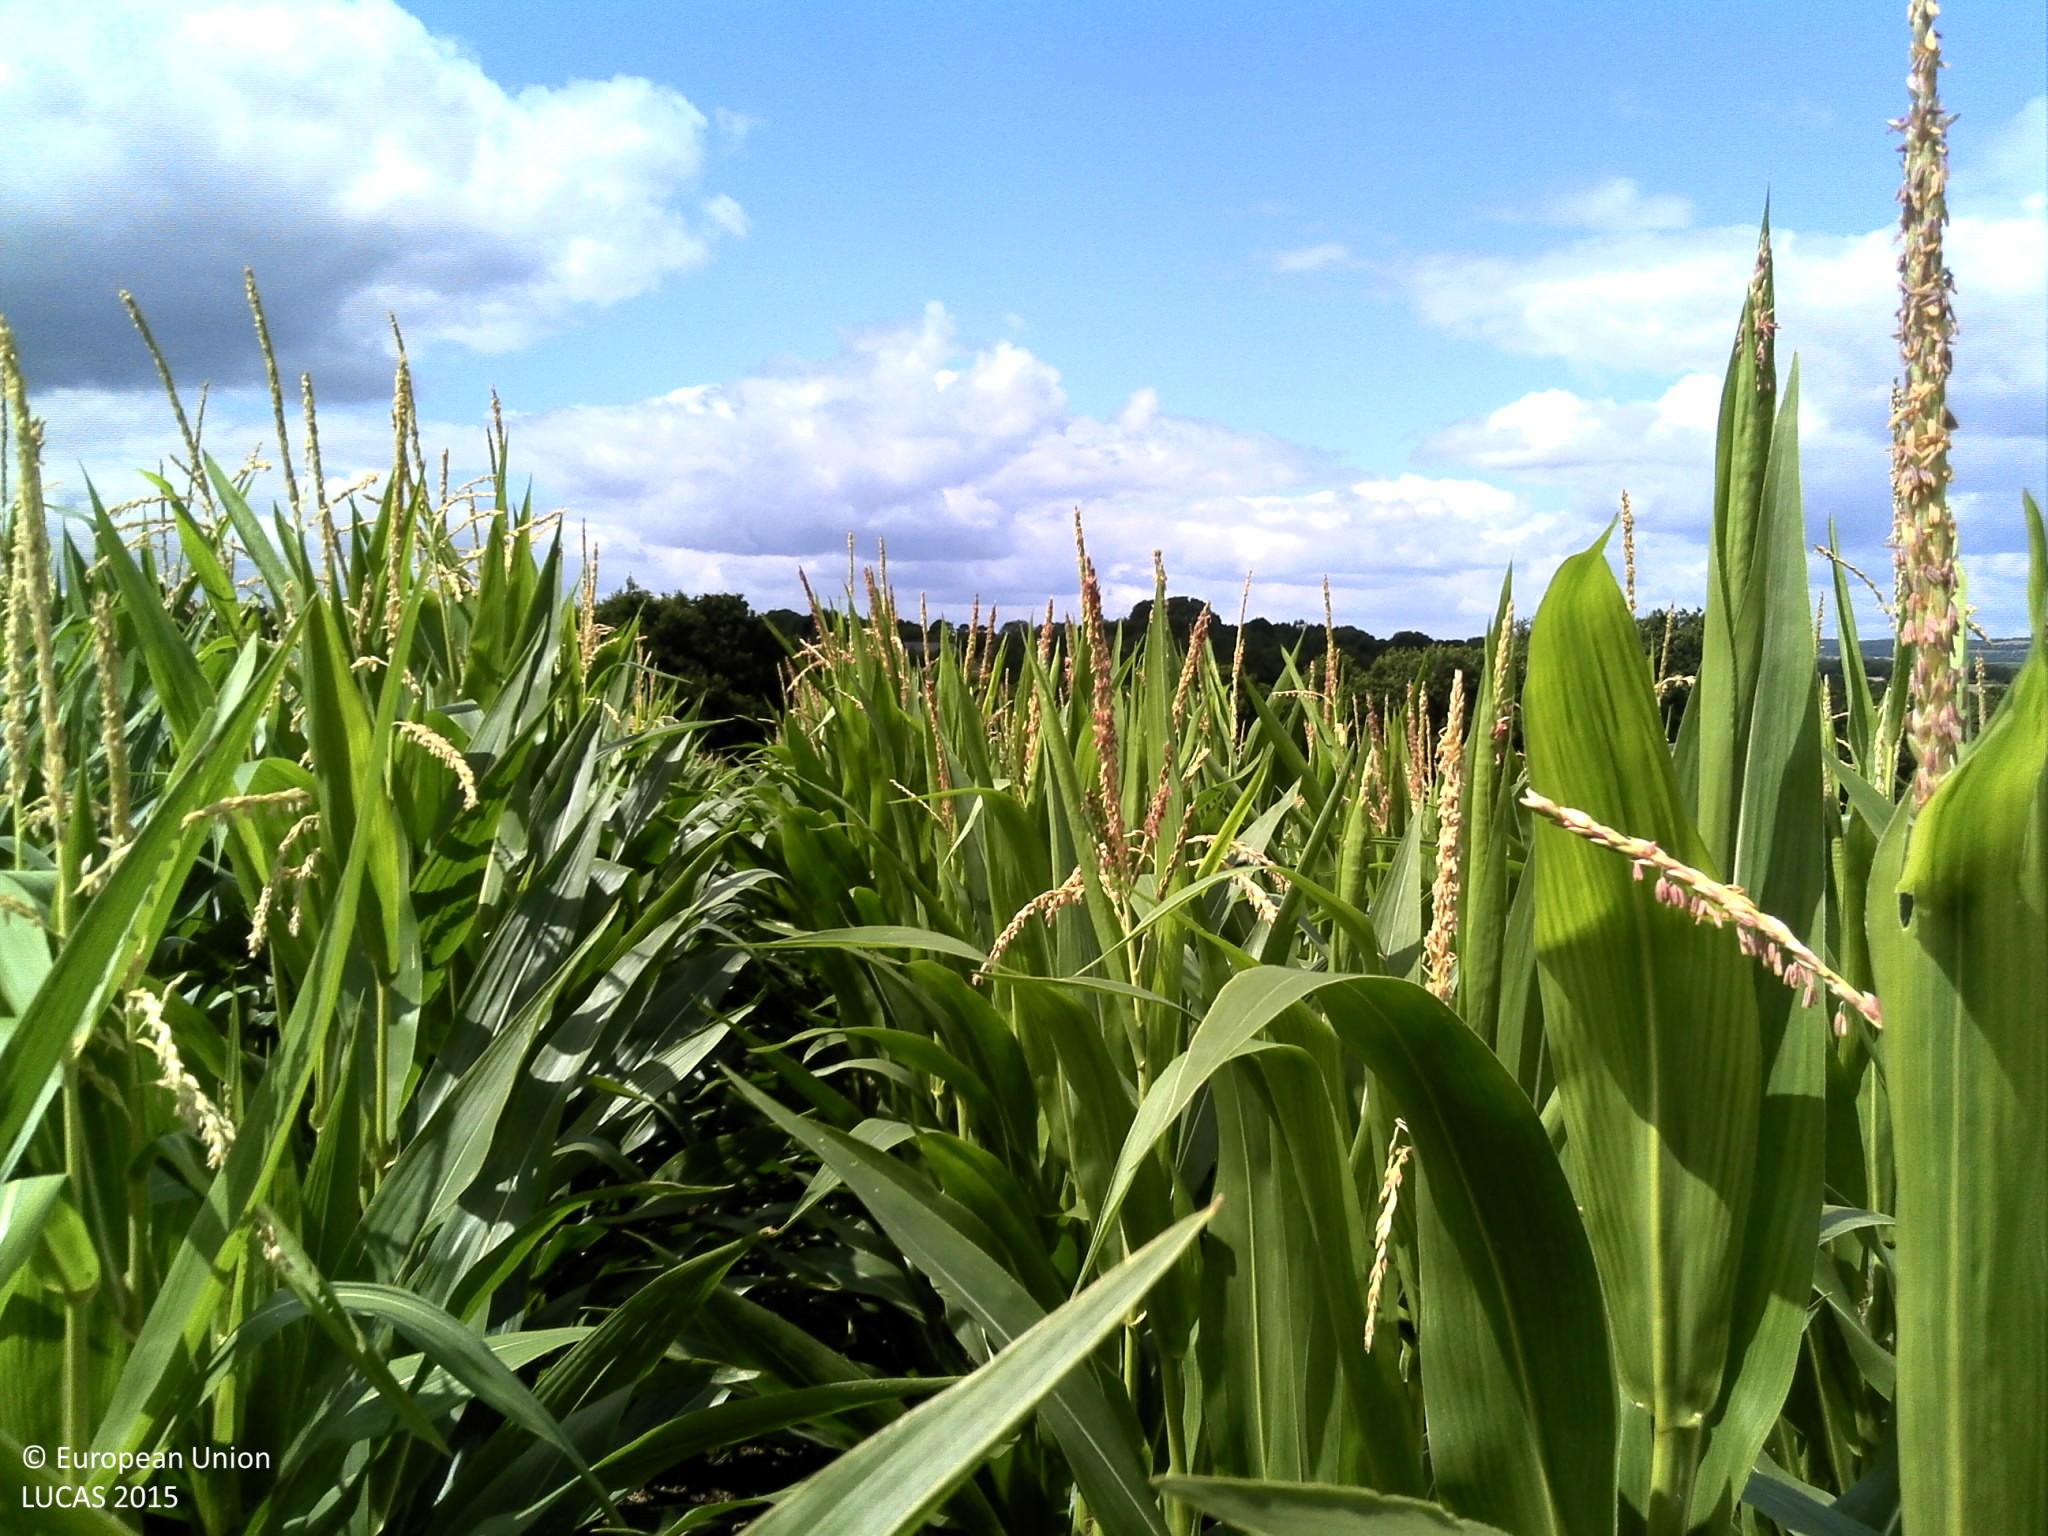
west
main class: Cropland
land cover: Maize
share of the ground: > 75 %
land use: Agriculture (excluding fallow land and kitchen gardens)
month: July
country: FR
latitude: 48.2927
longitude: -3.7092
